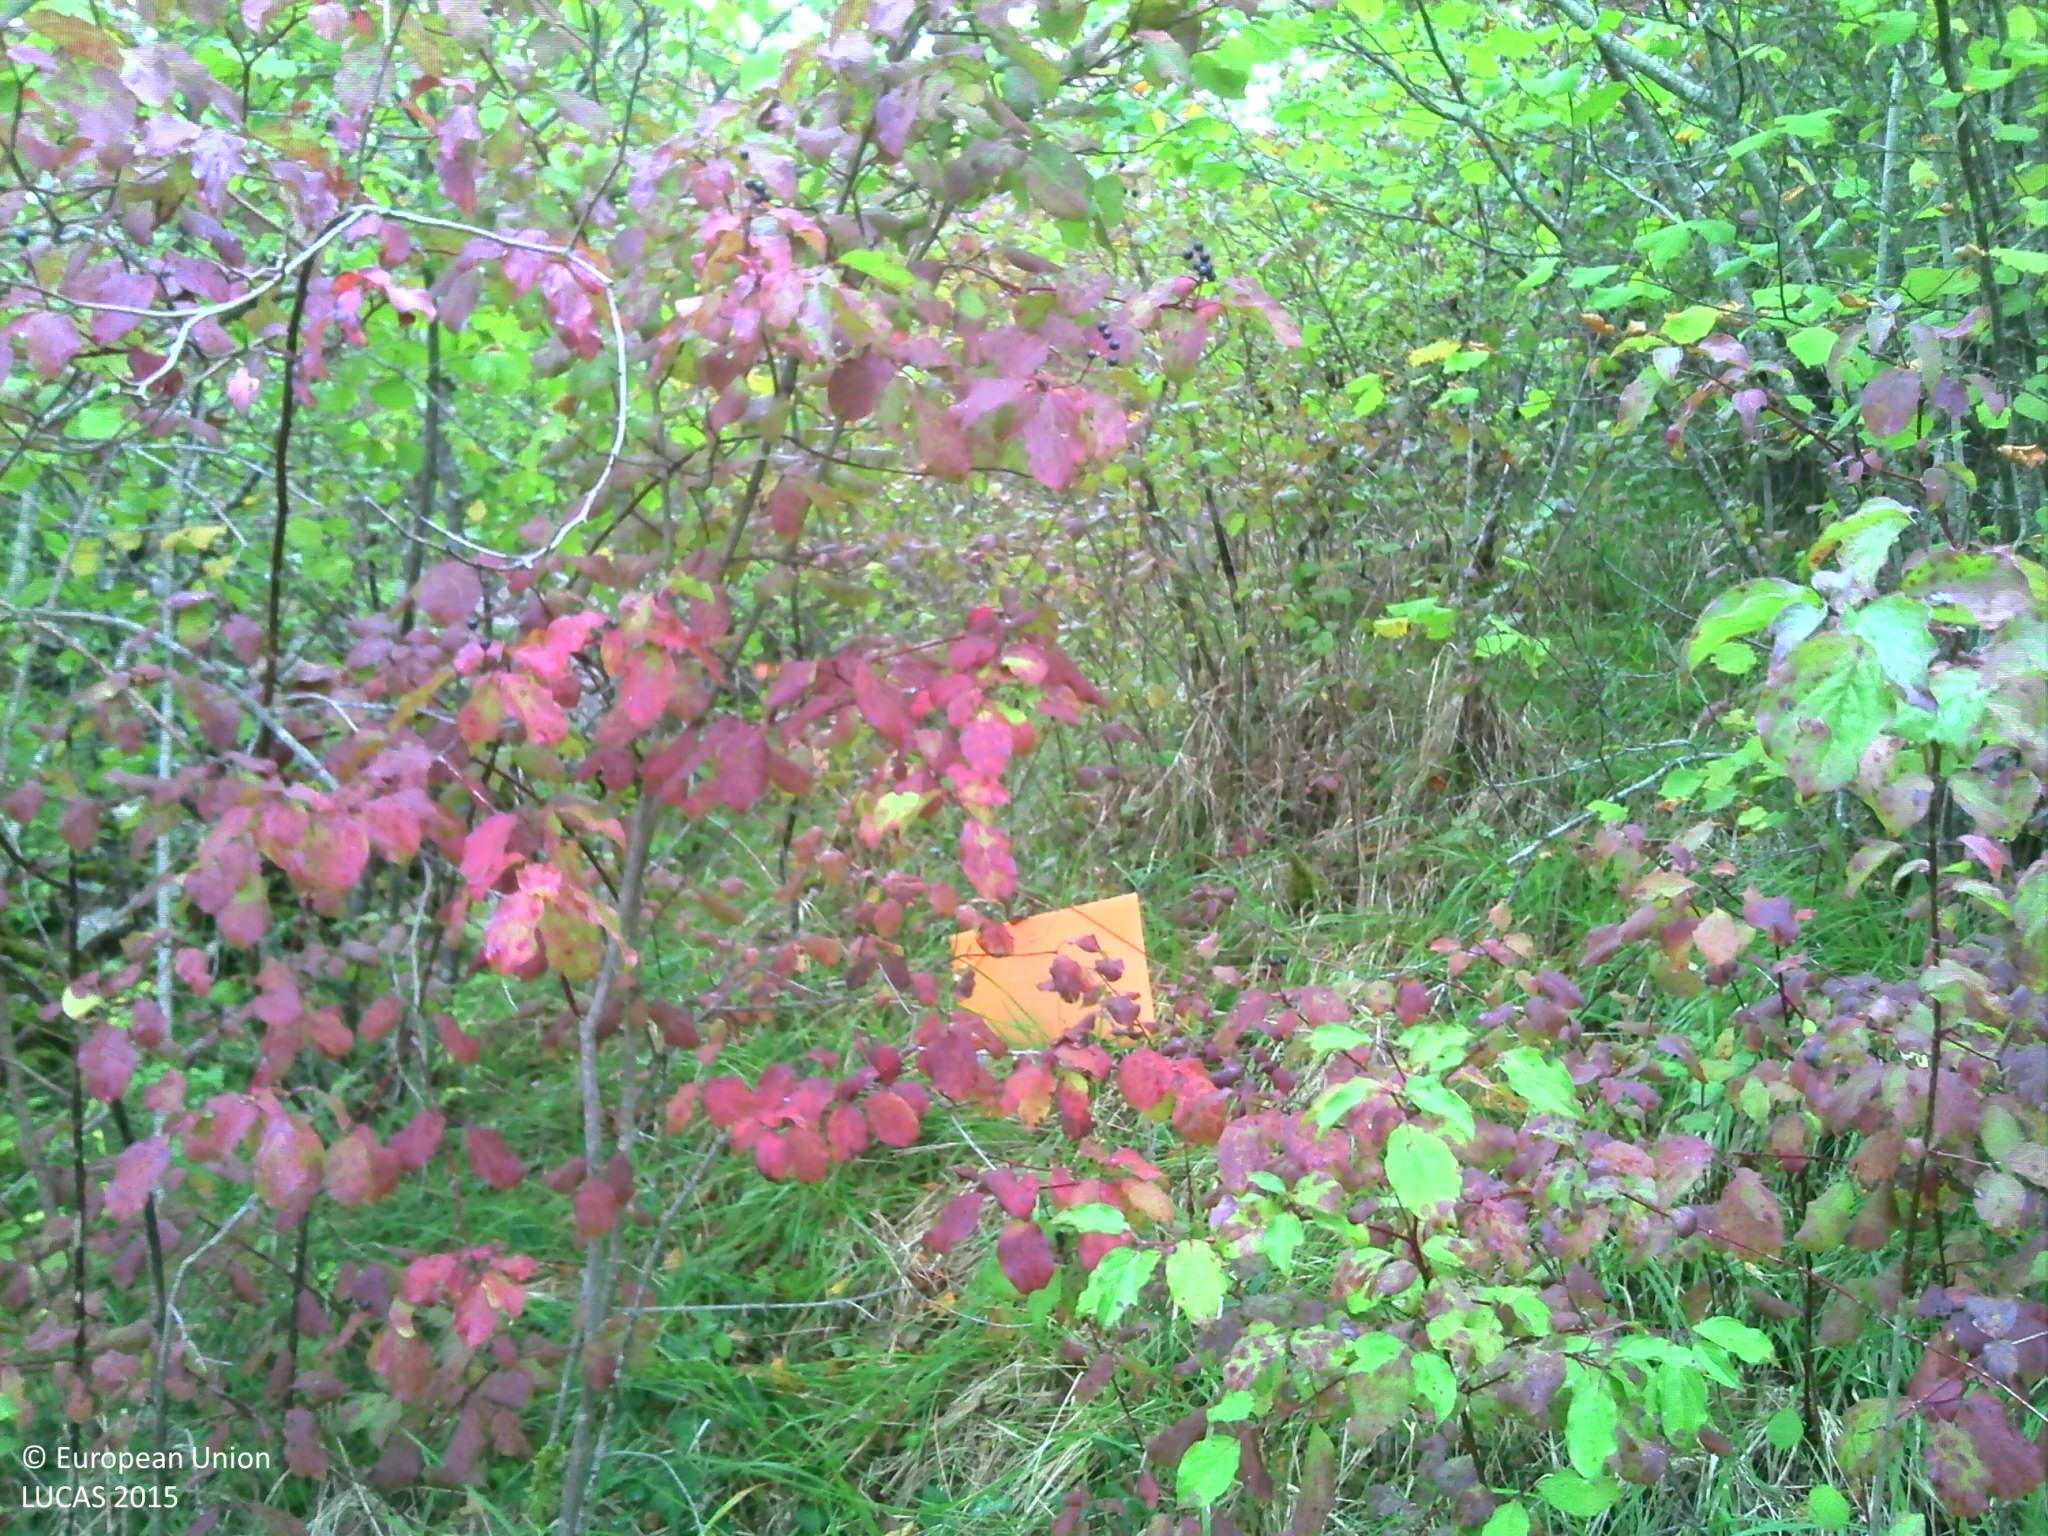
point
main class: Woodland
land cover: Broadleaved woodland
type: mesophytic deciduous forest
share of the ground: > 75 %
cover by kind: broadleaved forest trees 80 %, shrubs 10 %, herbaceous plants 10 %
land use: Semi-natural and natural areas not in use
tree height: < 5 m
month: September
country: FR
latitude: 47.0343
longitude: 4.7499
